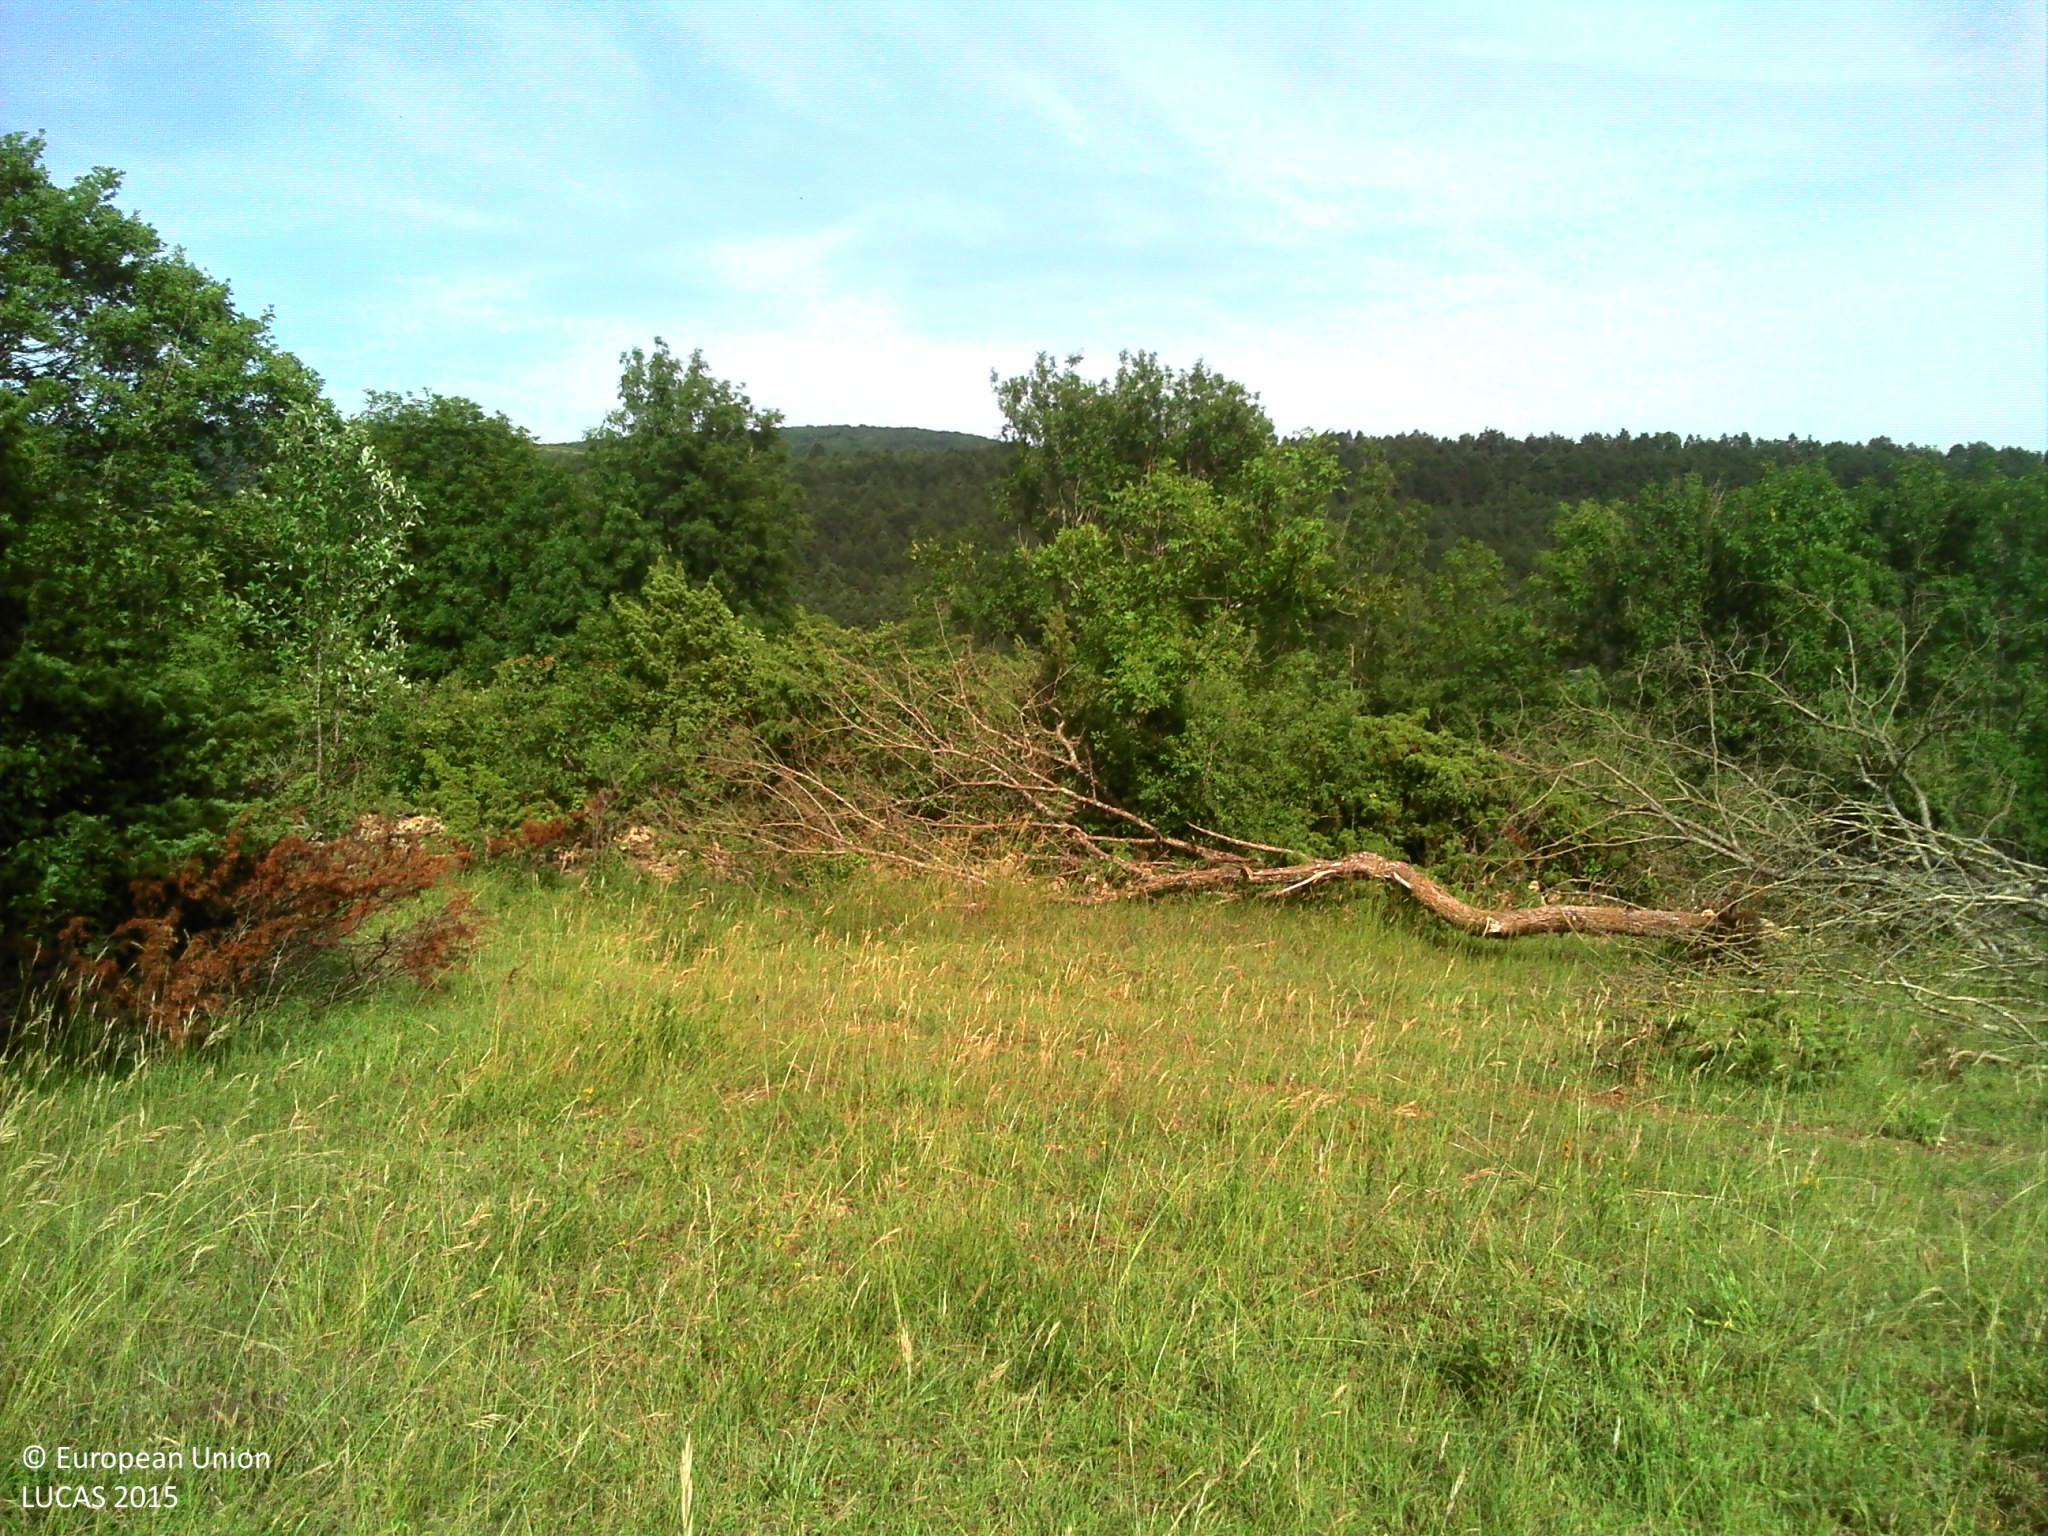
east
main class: Grassland
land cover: Grassland with sparse tree/shrub cover
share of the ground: > 75 %
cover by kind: herbaceous plants 95 %, broadleaved forest trees 5 %
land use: Agriculture (excluding fallow land and kitchen gardens)
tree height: < 5 m
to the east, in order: Grassland with sparse tree/shrub cover; Dry stone walls; Abandoned hedges; Grassland without tree/shrub cover; Other bare soil; Grassland without tree/shrub cover; Fences; Grassland without tree/shrub cover; Other bare soil; Fences; Tracks; Grass margins; Fences; Other bare soil; Grassland without tree/shrub cover; Broadleaved woodland; Grassland without tree/shrub cover
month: June
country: FR
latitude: 46.3601
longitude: 5.3889
